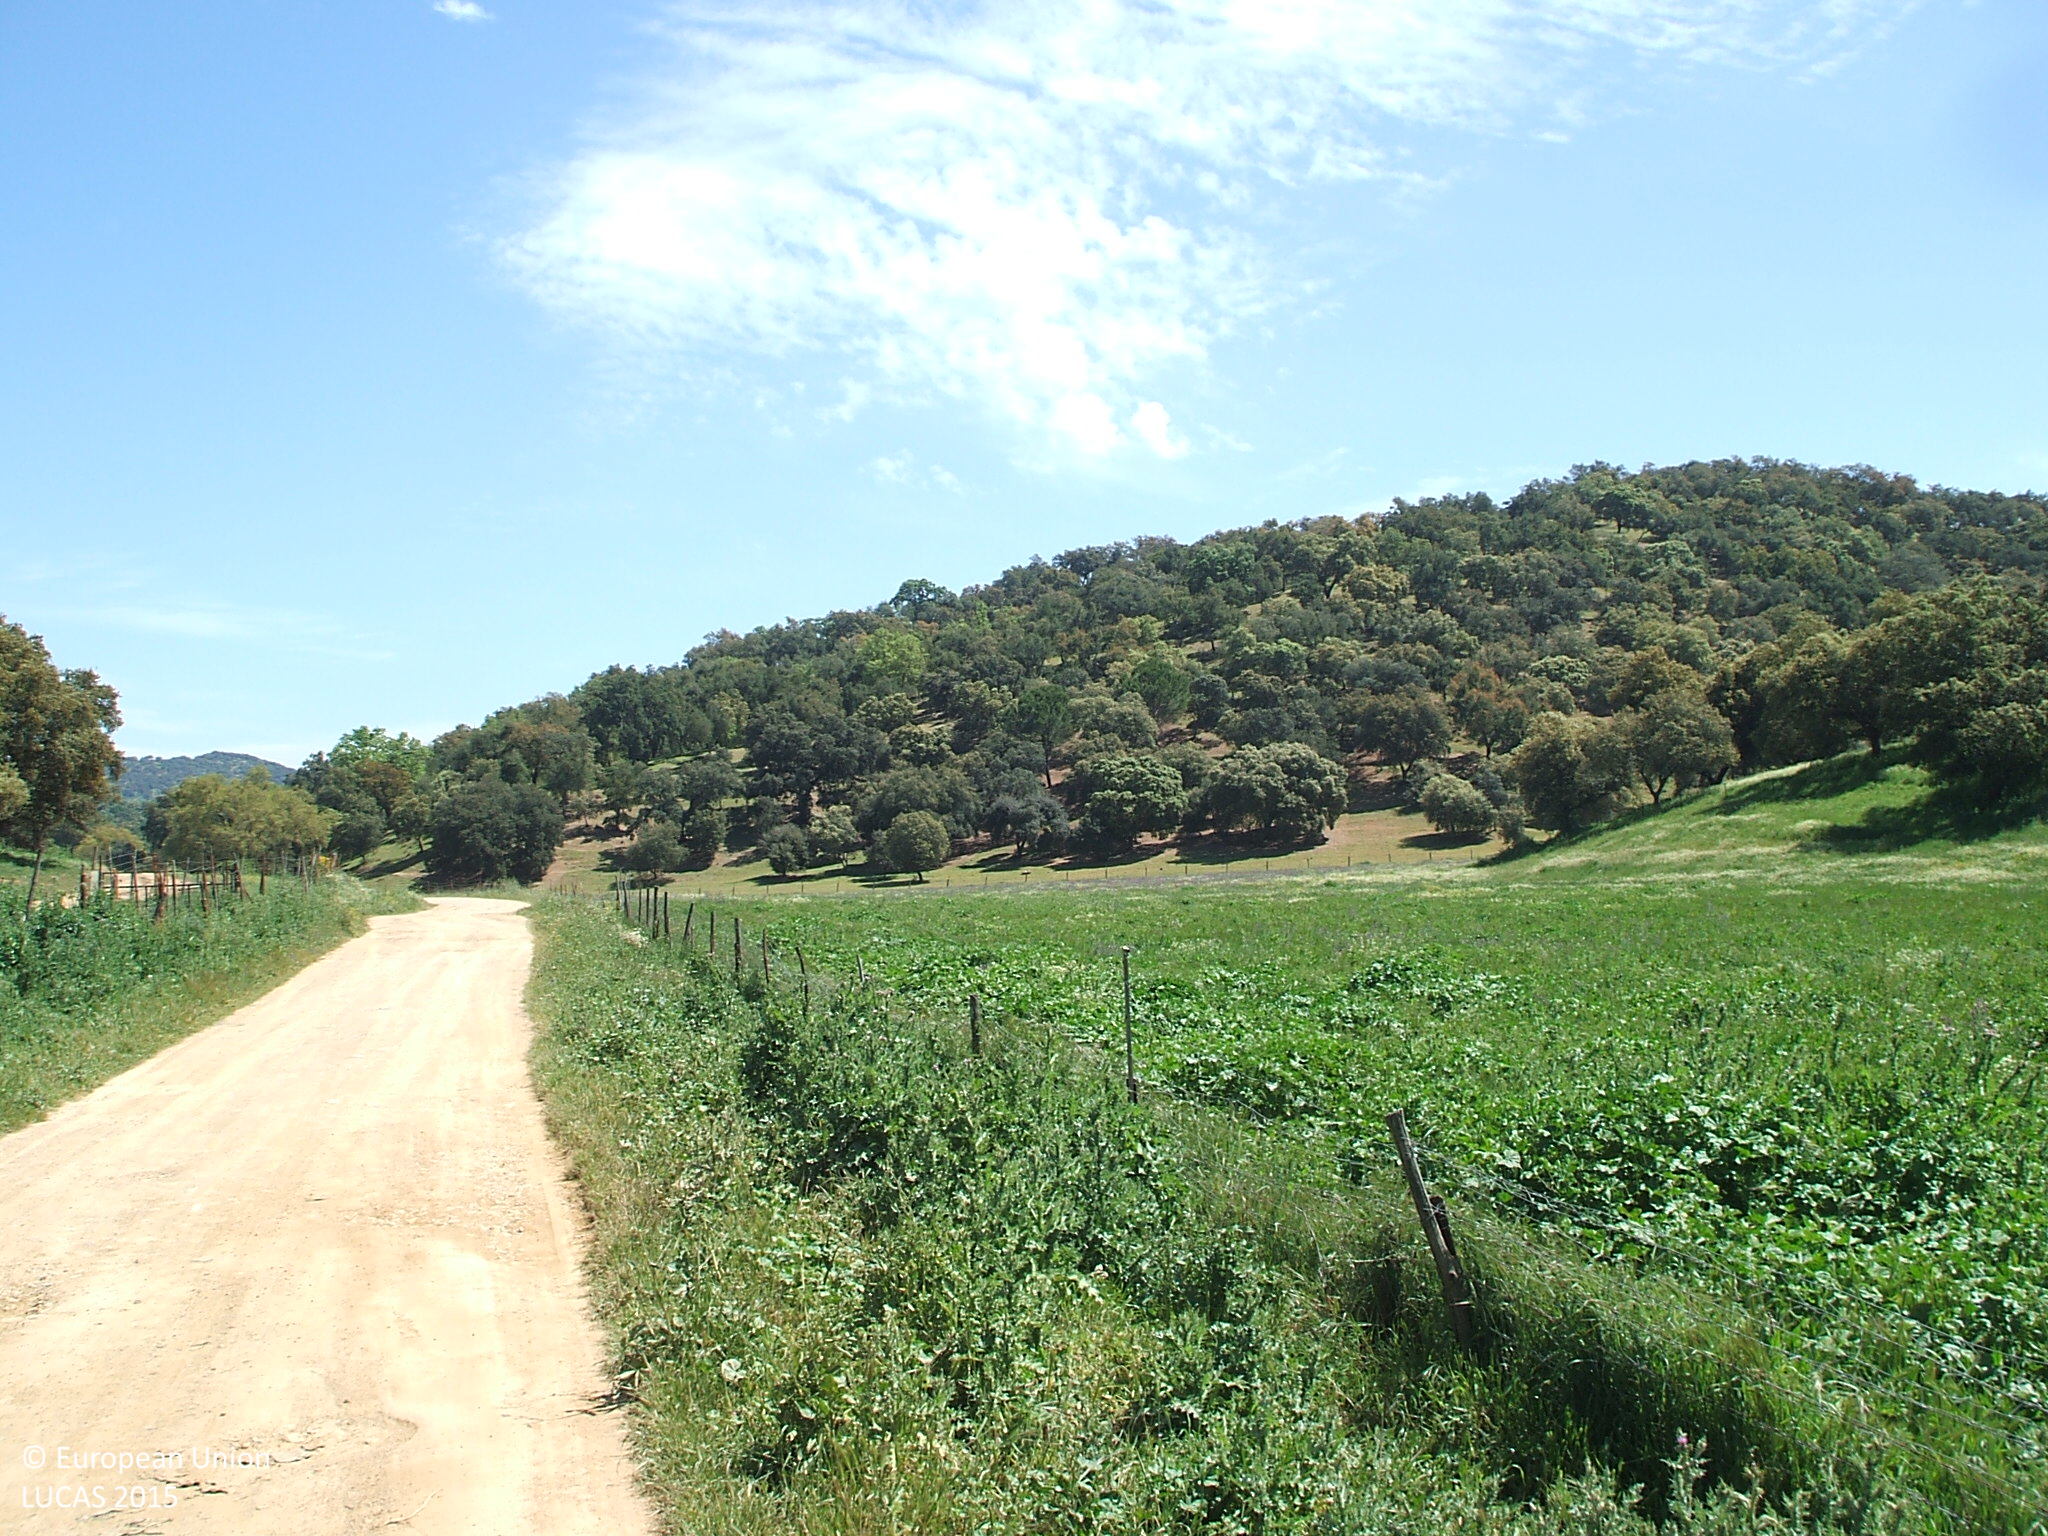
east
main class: Woodland
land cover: Broadleaved woodland
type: broadleaved evergreen forest
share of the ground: 50 - 75 %
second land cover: Grassland without tree/shrub cover
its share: > 75 %
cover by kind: broadleaved forest trees 50 %, herbaceous plants 50 %
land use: Forestry
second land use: Agriculture (excluding fallow land and kitchen gardens)
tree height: > 5 m
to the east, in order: Broadleaved woodland; Grassland without tree/shrub cover; Tracks; Grassland without tree/shrub cover; Fences; Broadleaved woodland
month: April
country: ES
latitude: 37.8961
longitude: -5.6641
